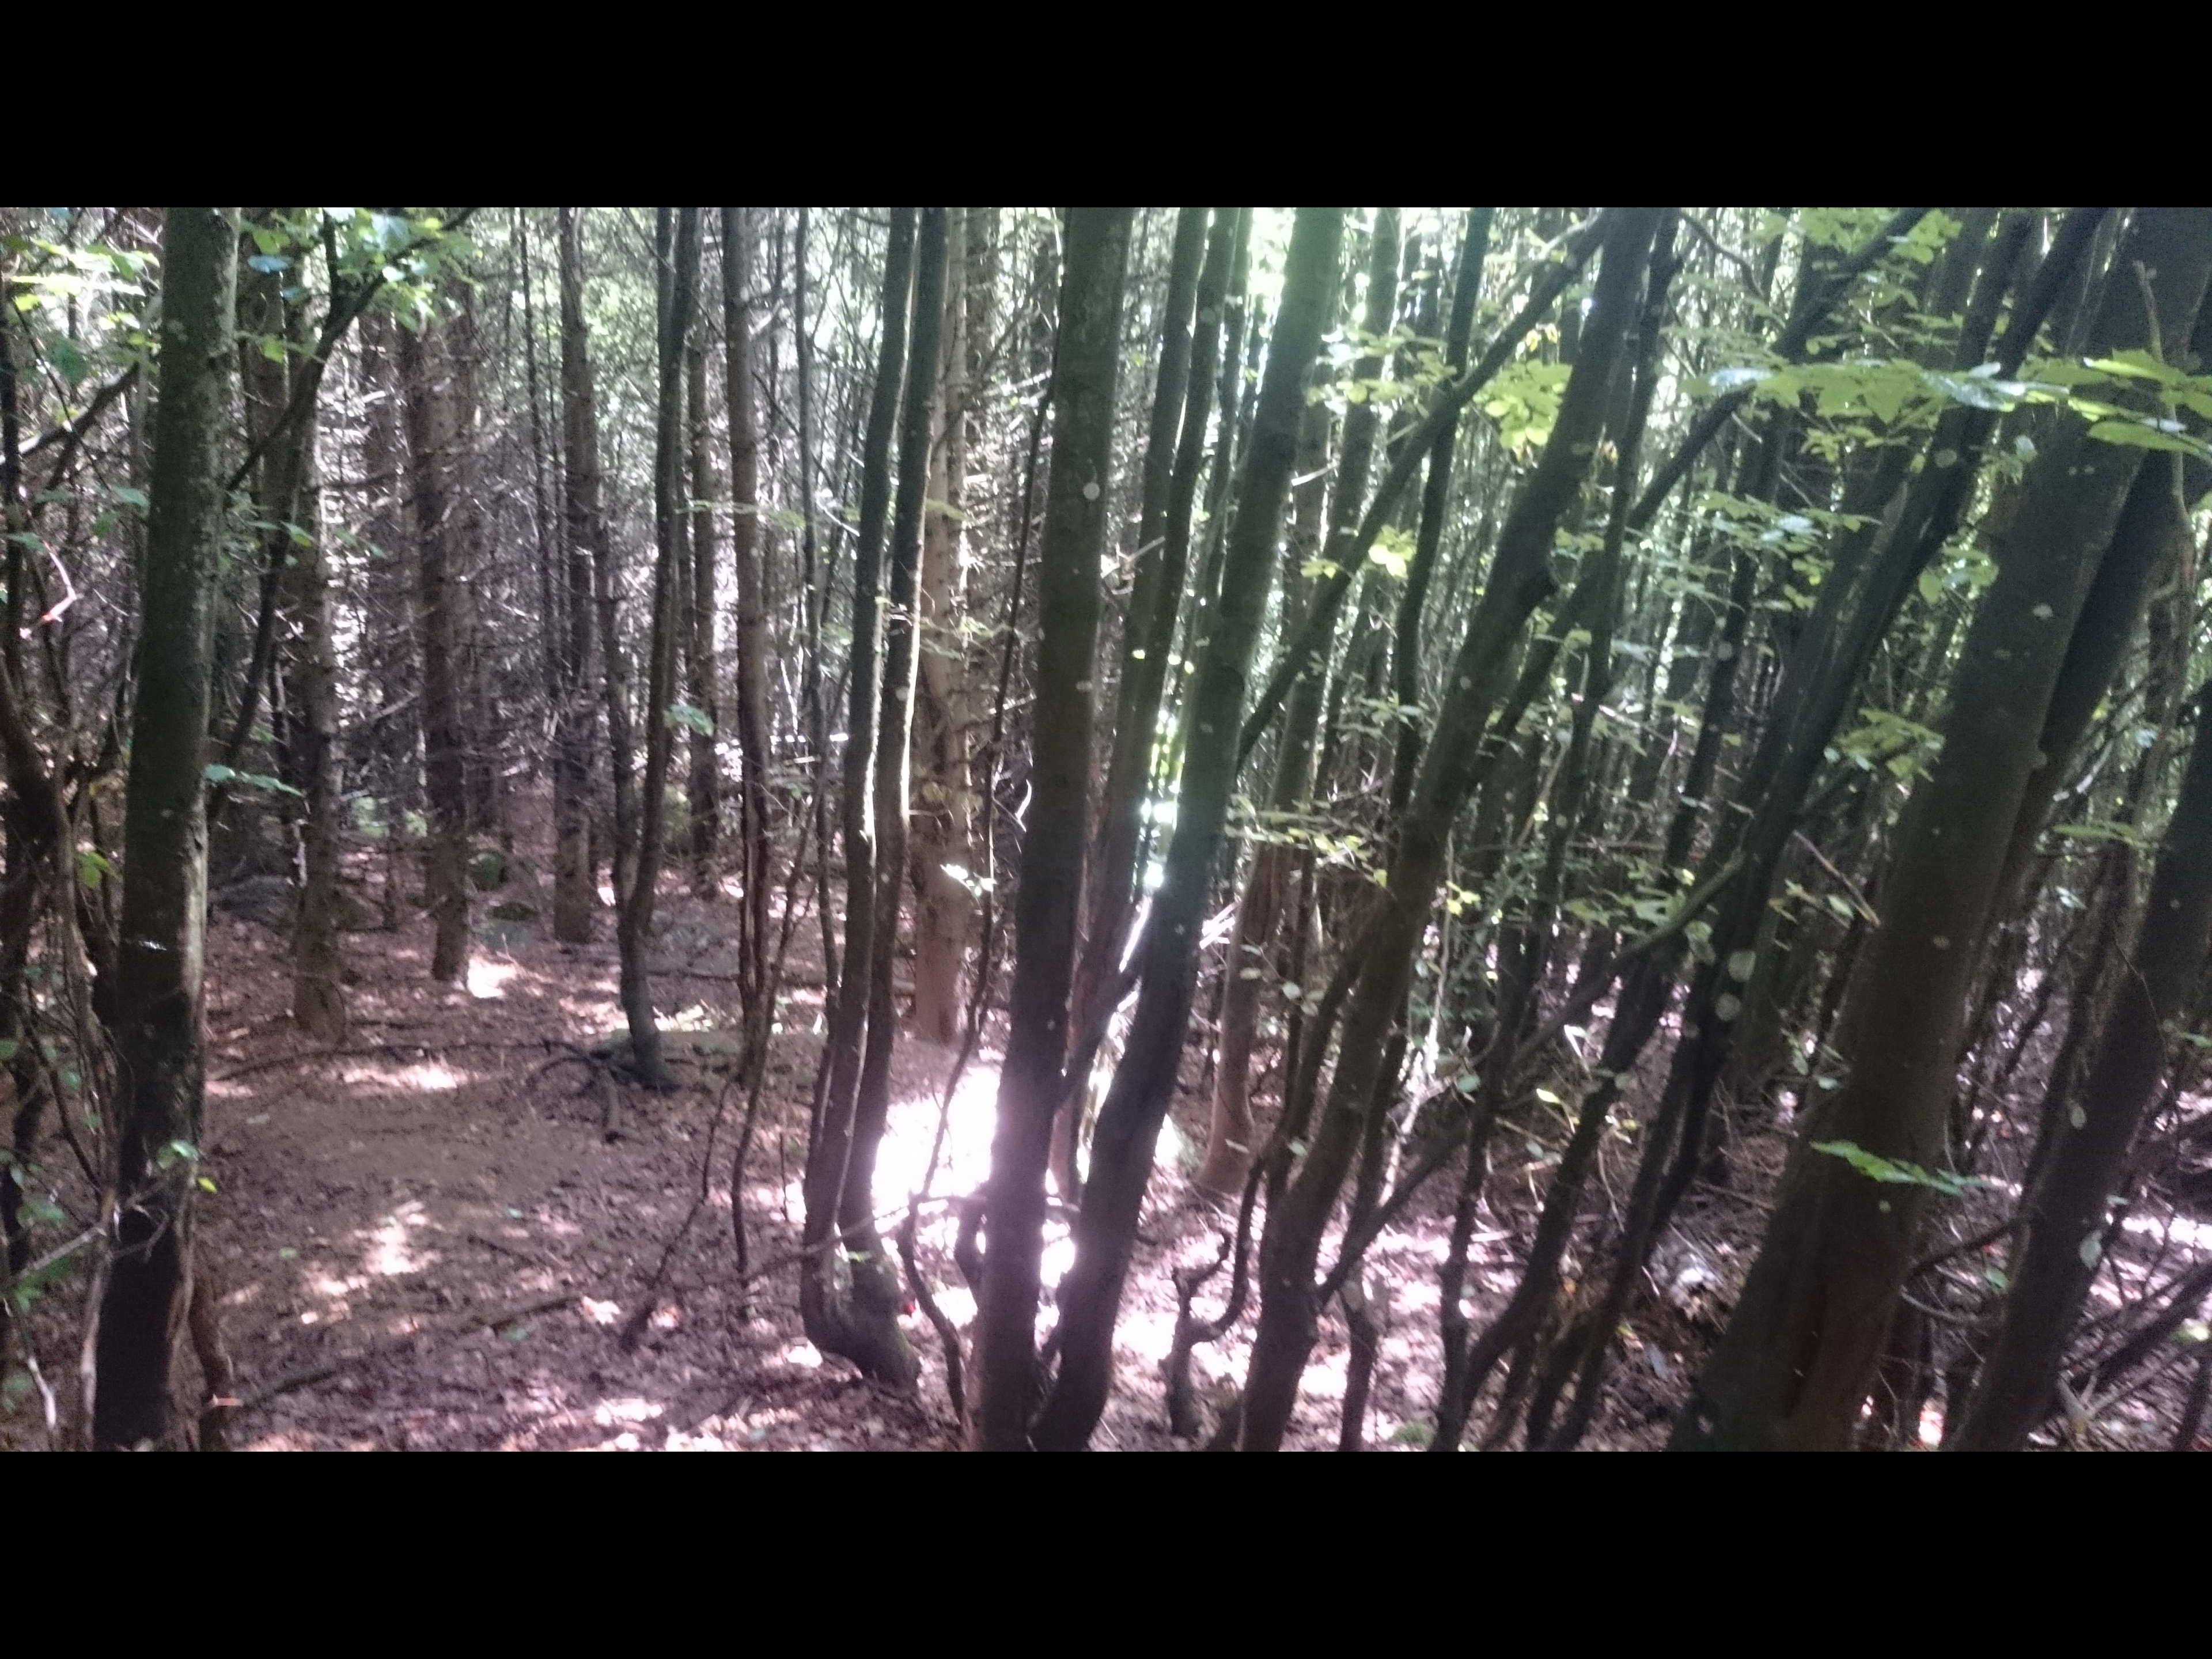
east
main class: Woodland
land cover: Spruce dominated mixed woodland
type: hemiboreal forest and nemoral coniferous forest and mixed broadleaved-coniferous forest
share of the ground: > 75 %
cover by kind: coniferous forest trees 65 %, broadleaved forest trees 30 %, unconsolidated bare surface 5 %
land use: Forestry
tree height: > 5 m
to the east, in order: Spruce dominated mixed woodland; Spruce dominated coniferous woodland
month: June
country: AT
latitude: 48.6444
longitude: 14.7380
